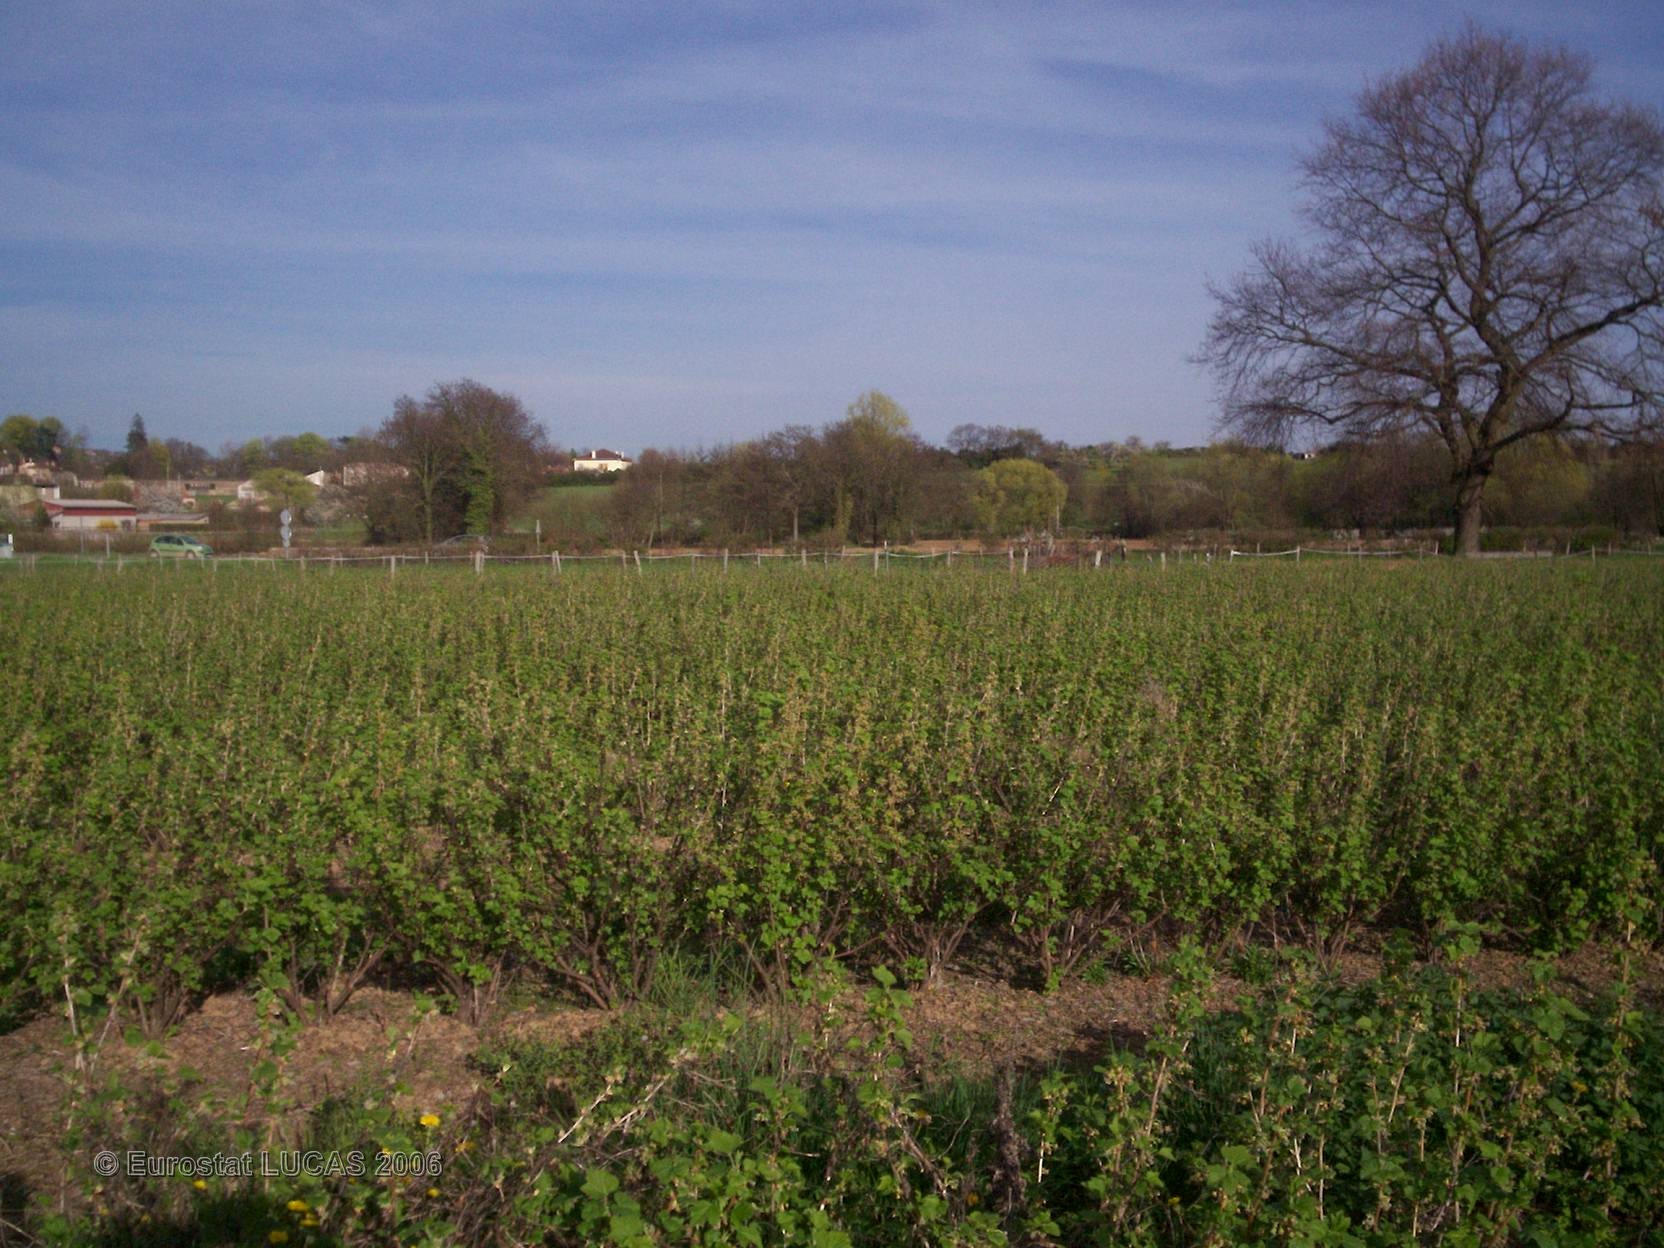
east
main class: Cropland
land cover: Other fruit trees and berries
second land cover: Grassland with sparse tree/shrub cover
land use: Agriculture (excluding fallow land and kitchen gardens)
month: April
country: FR
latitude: 46.3302
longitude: 4.7412
